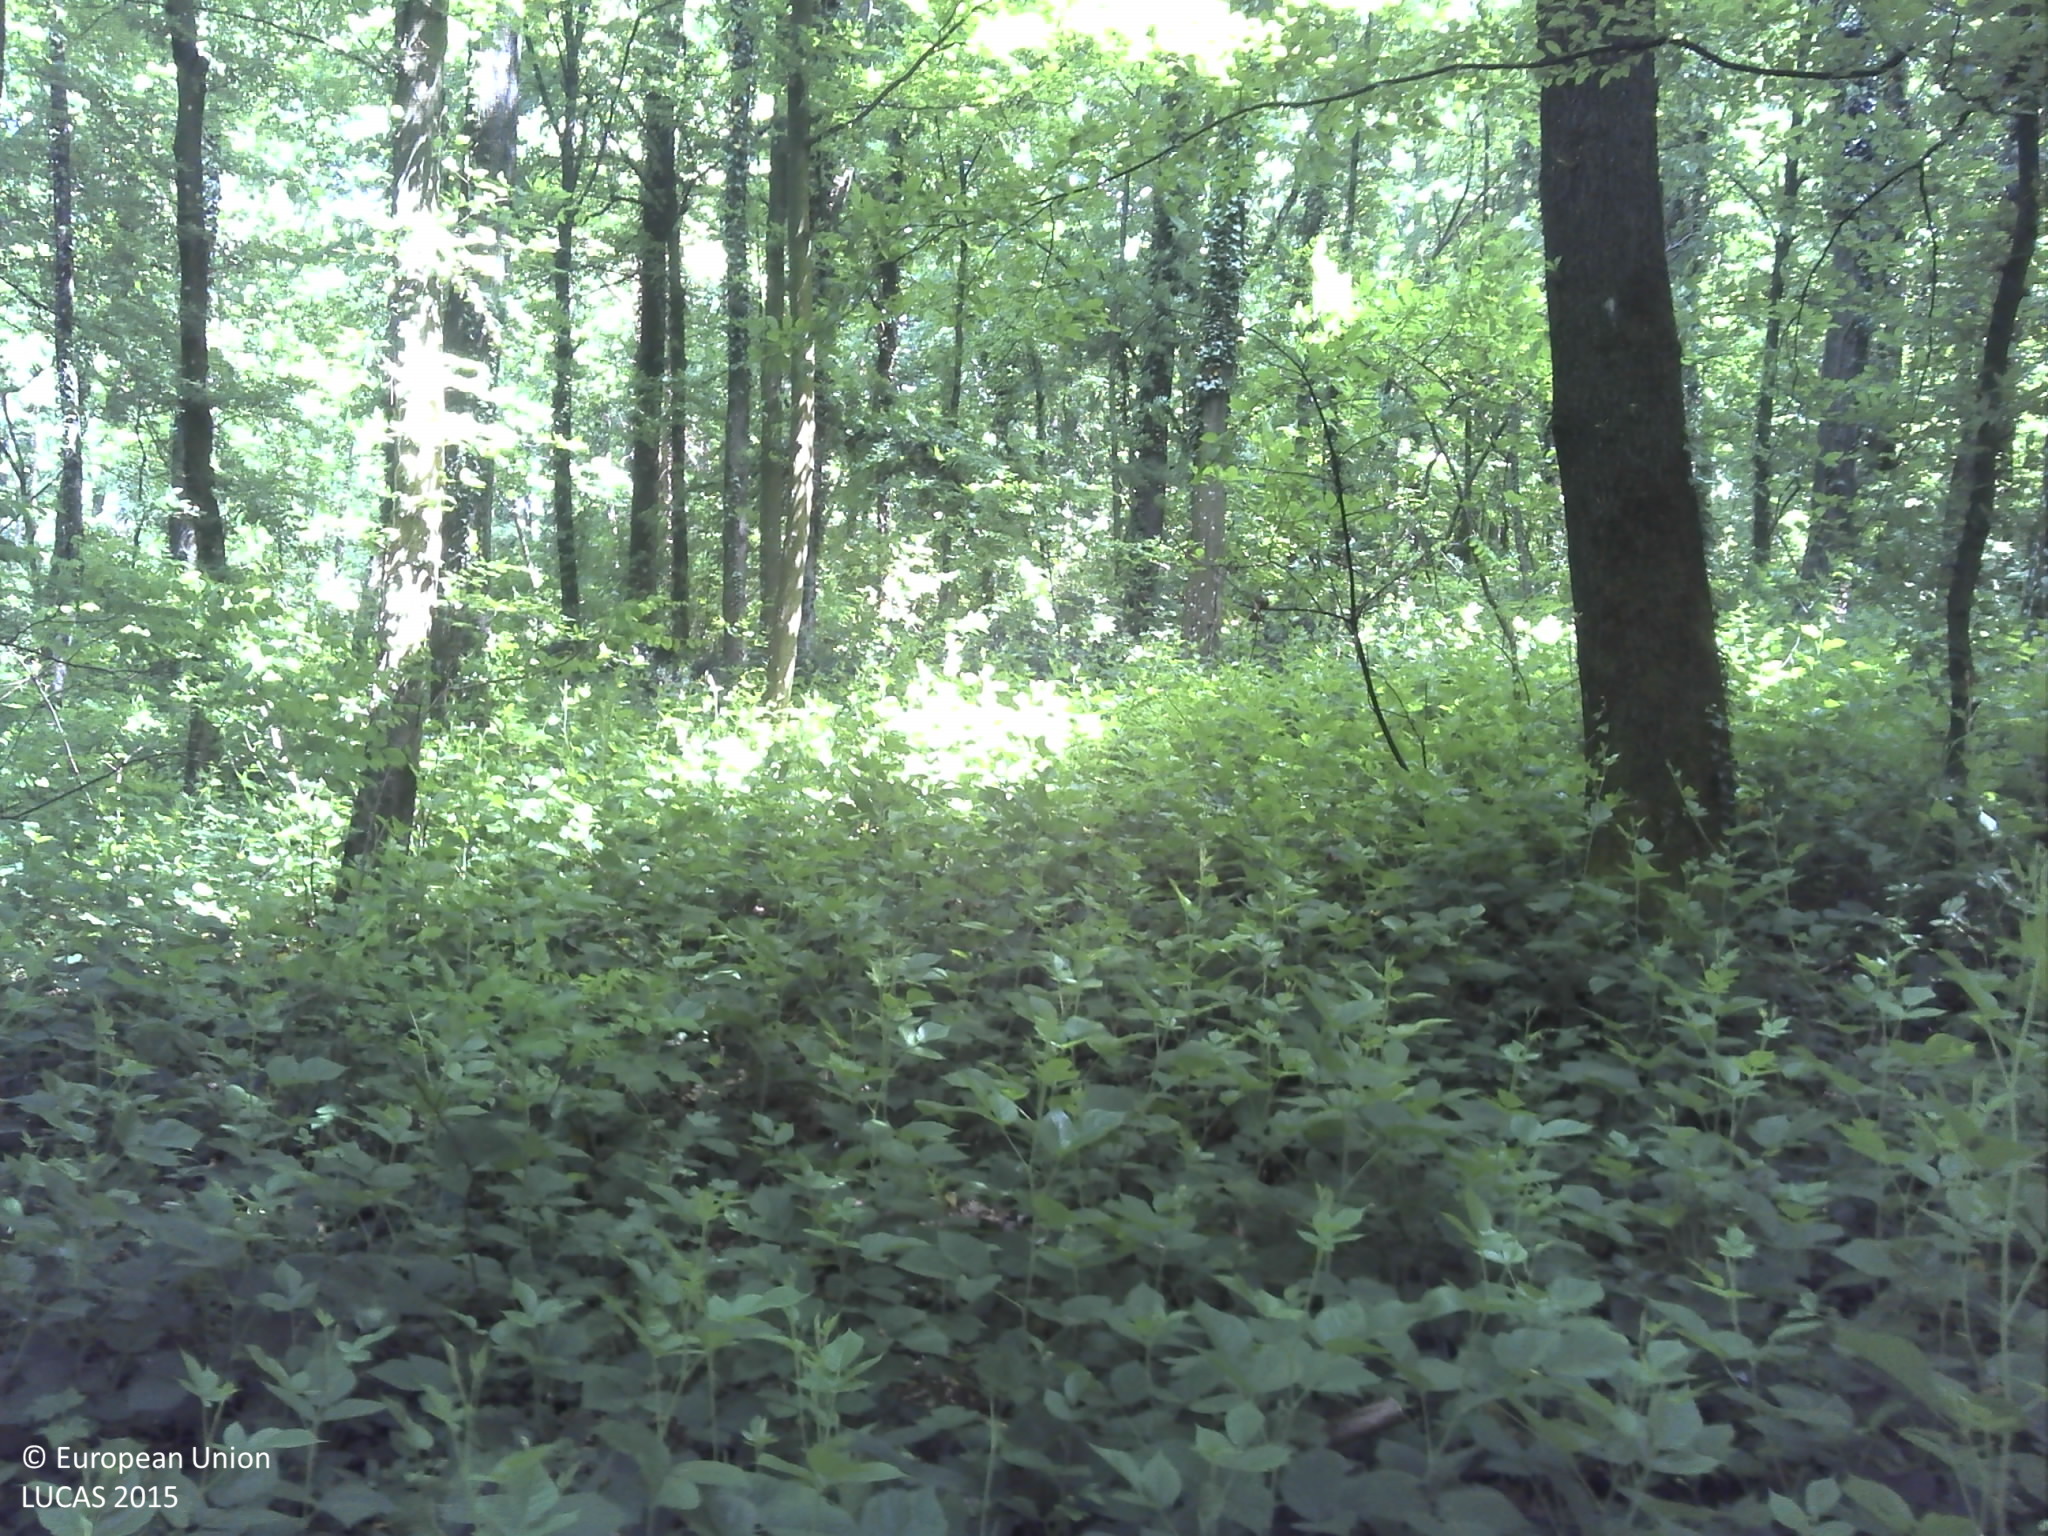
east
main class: Woodland
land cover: Broadleaved woodland
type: acidophilous oak and oak-birch forest
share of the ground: > 75 %
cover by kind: broadleaved forest trees 80 %, lichens and mosses 20 %
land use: Forestry
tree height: > 5 m
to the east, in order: Broadleaved woodland
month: May
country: HR
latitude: 45.2716
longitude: 18.2508
